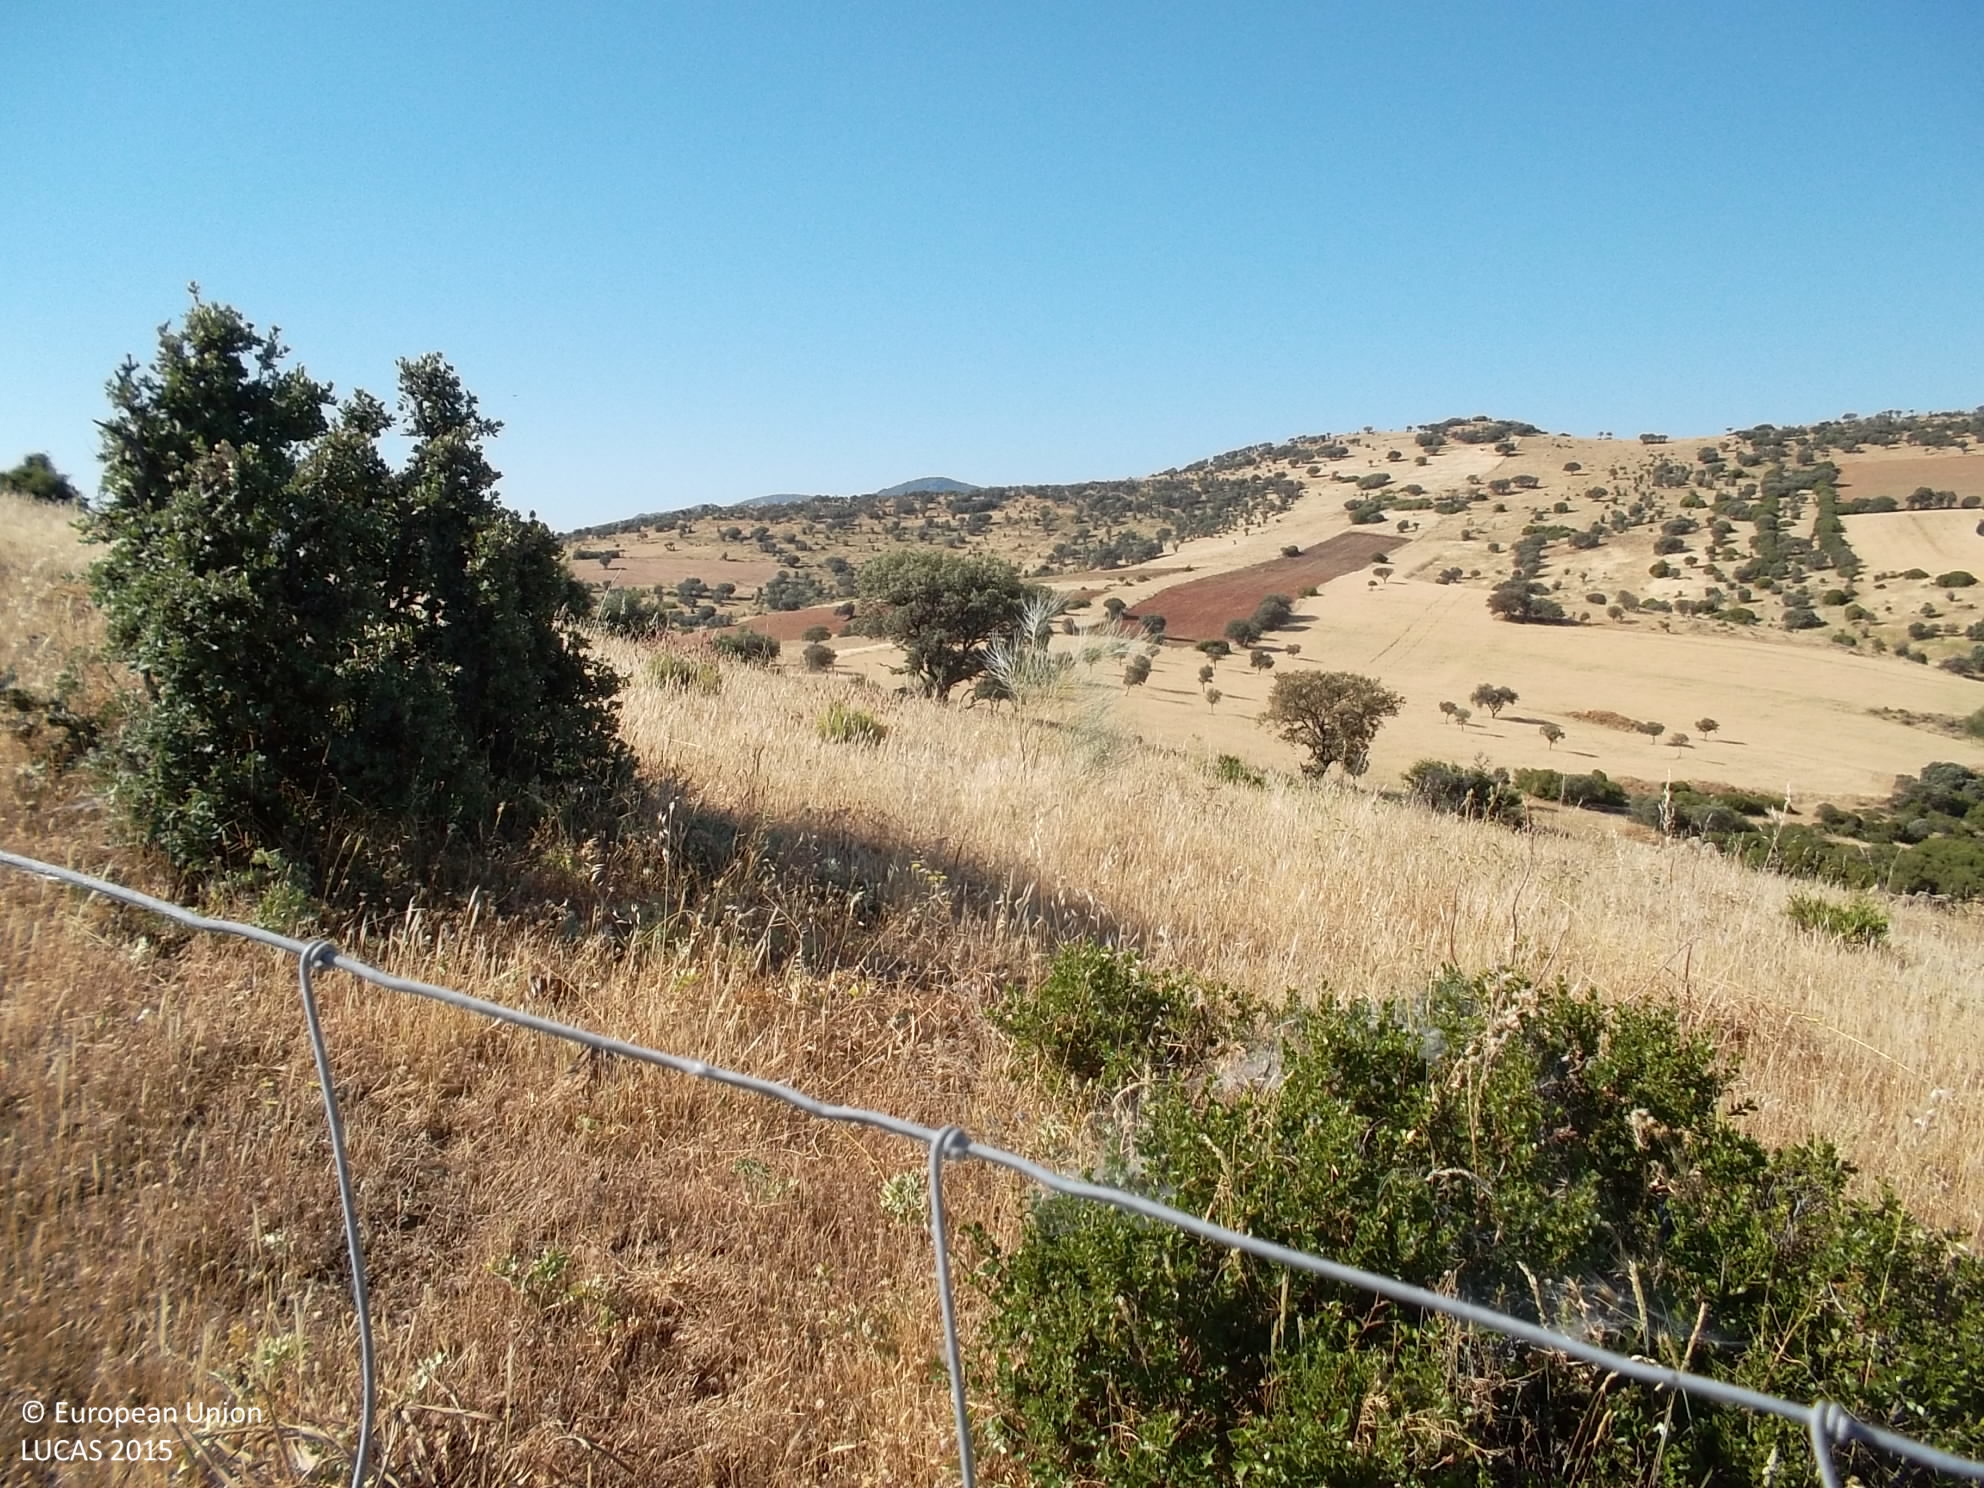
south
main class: Woodland
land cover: Broadleaved woodland
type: broadleaved evergreen forest
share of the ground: 25 - 50 %
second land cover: Spontaneously vegetated surfaces
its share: 50 - 75 %
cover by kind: herbaceous plants 50 %, shrubs 30 %, broadleaved forest trees 20 %
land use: Forestry
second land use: Agriculture (excluding fallow land and kitchen gardens)
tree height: < 5 m
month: May
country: ES
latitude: 38.6092
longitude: -3.9217
